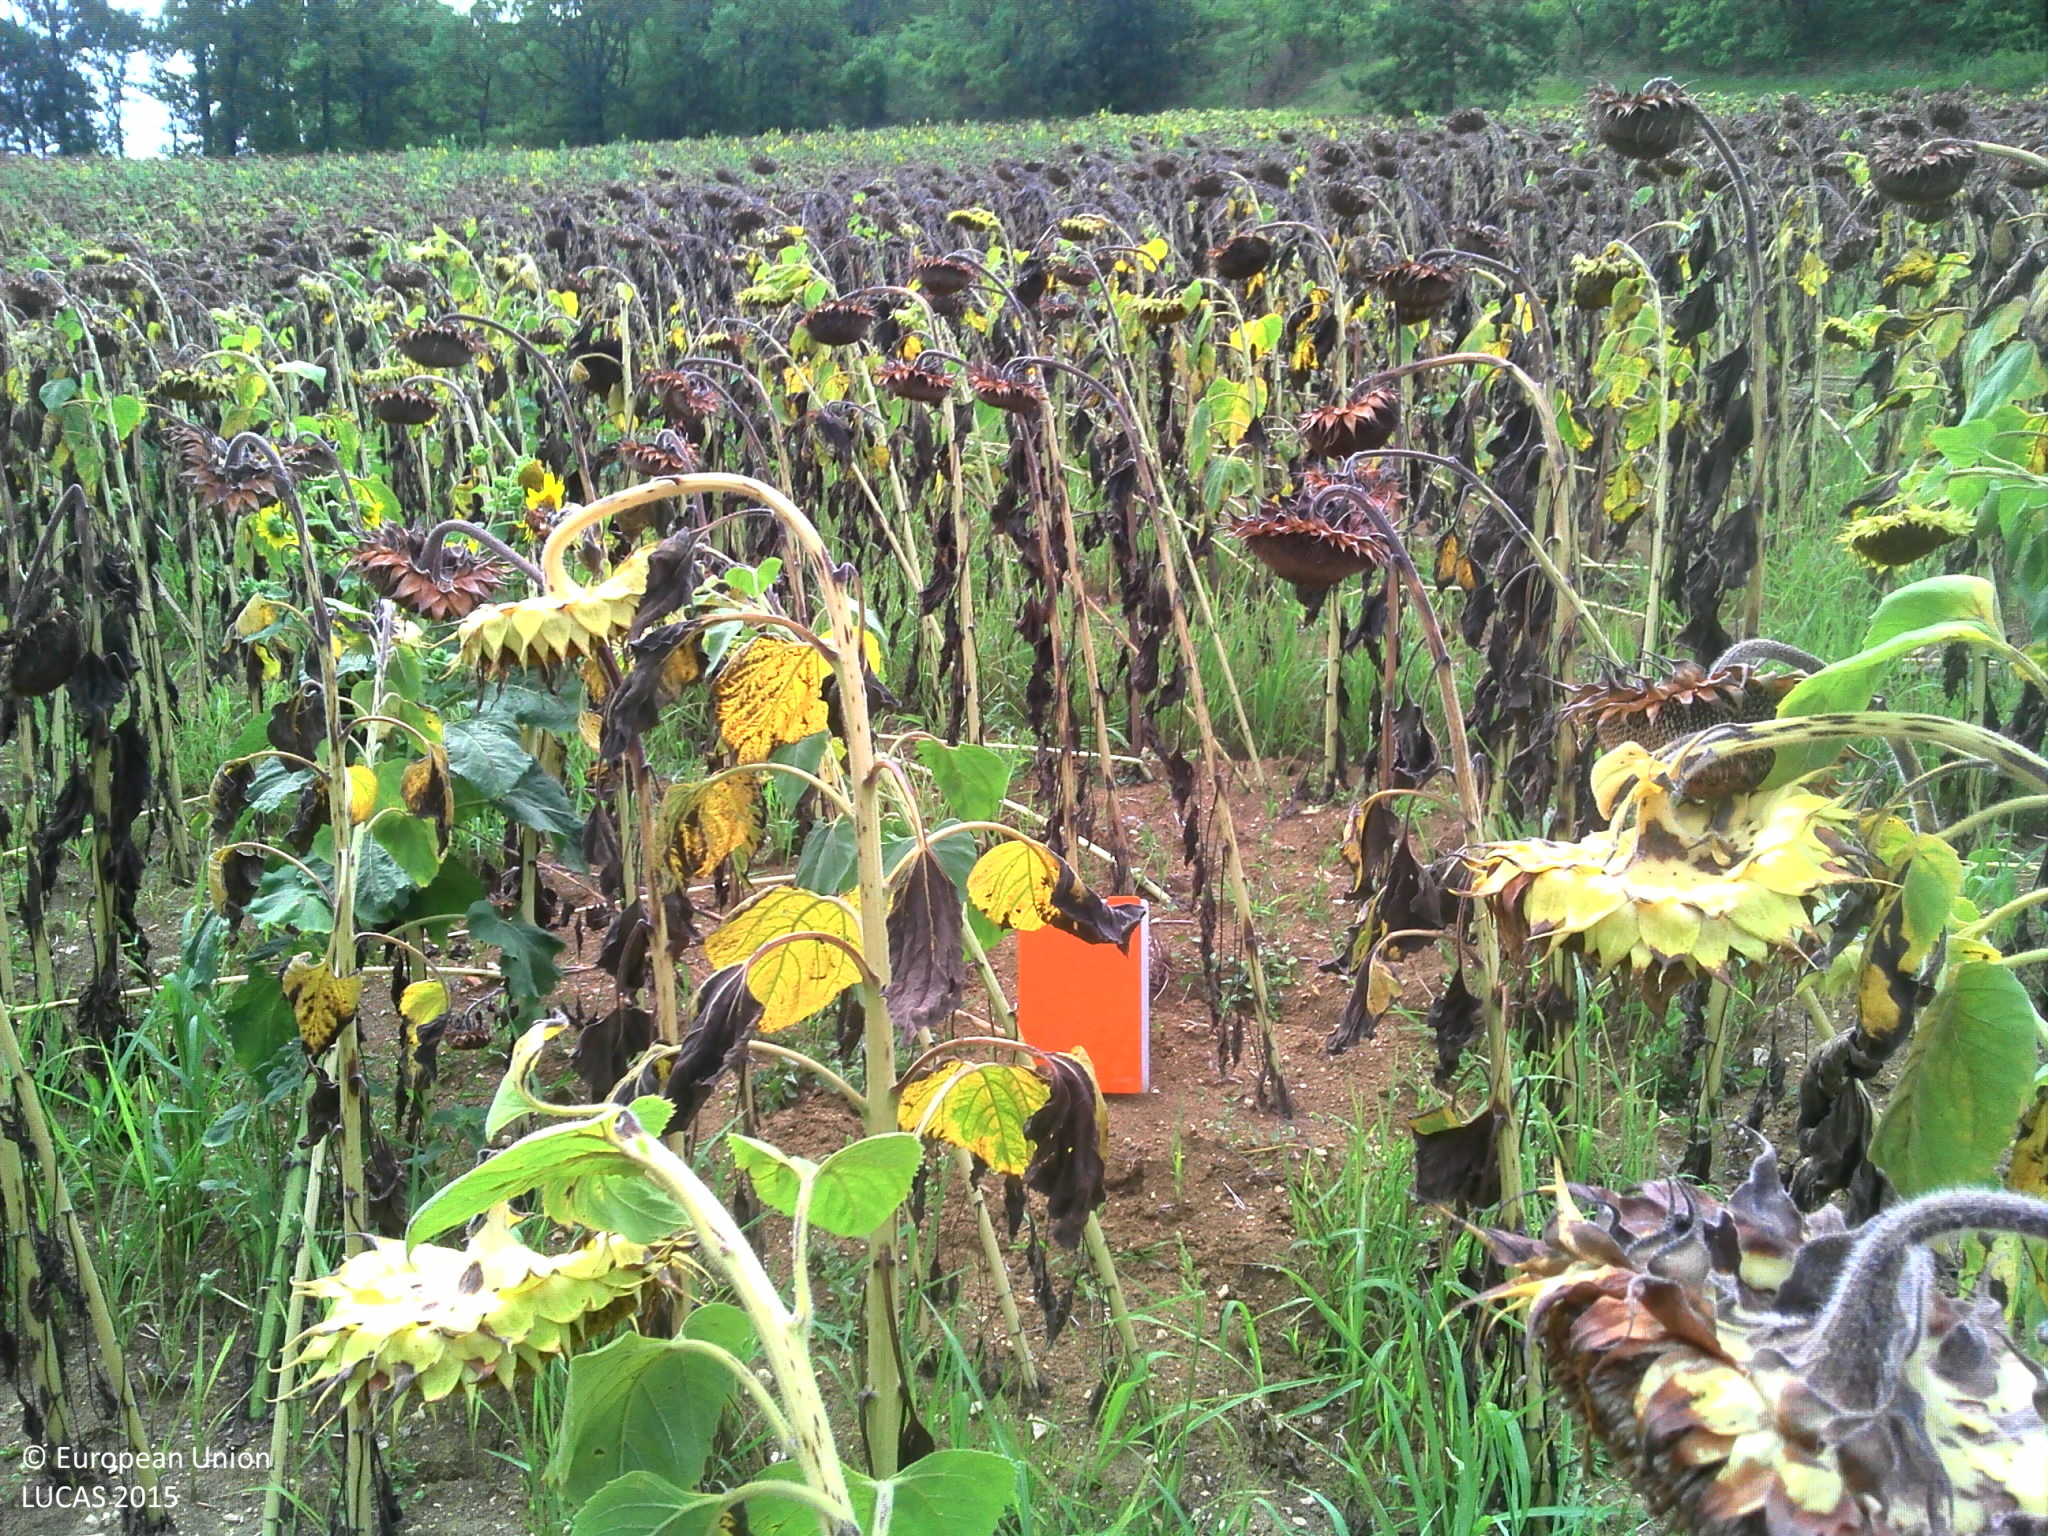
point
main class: Cropland
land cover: Sunflower
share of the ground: > 75 %
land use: Agriculture (excluding fallow land and kitchen gardens)
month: August
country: FR
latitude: 44.3118
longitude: 1.3102
